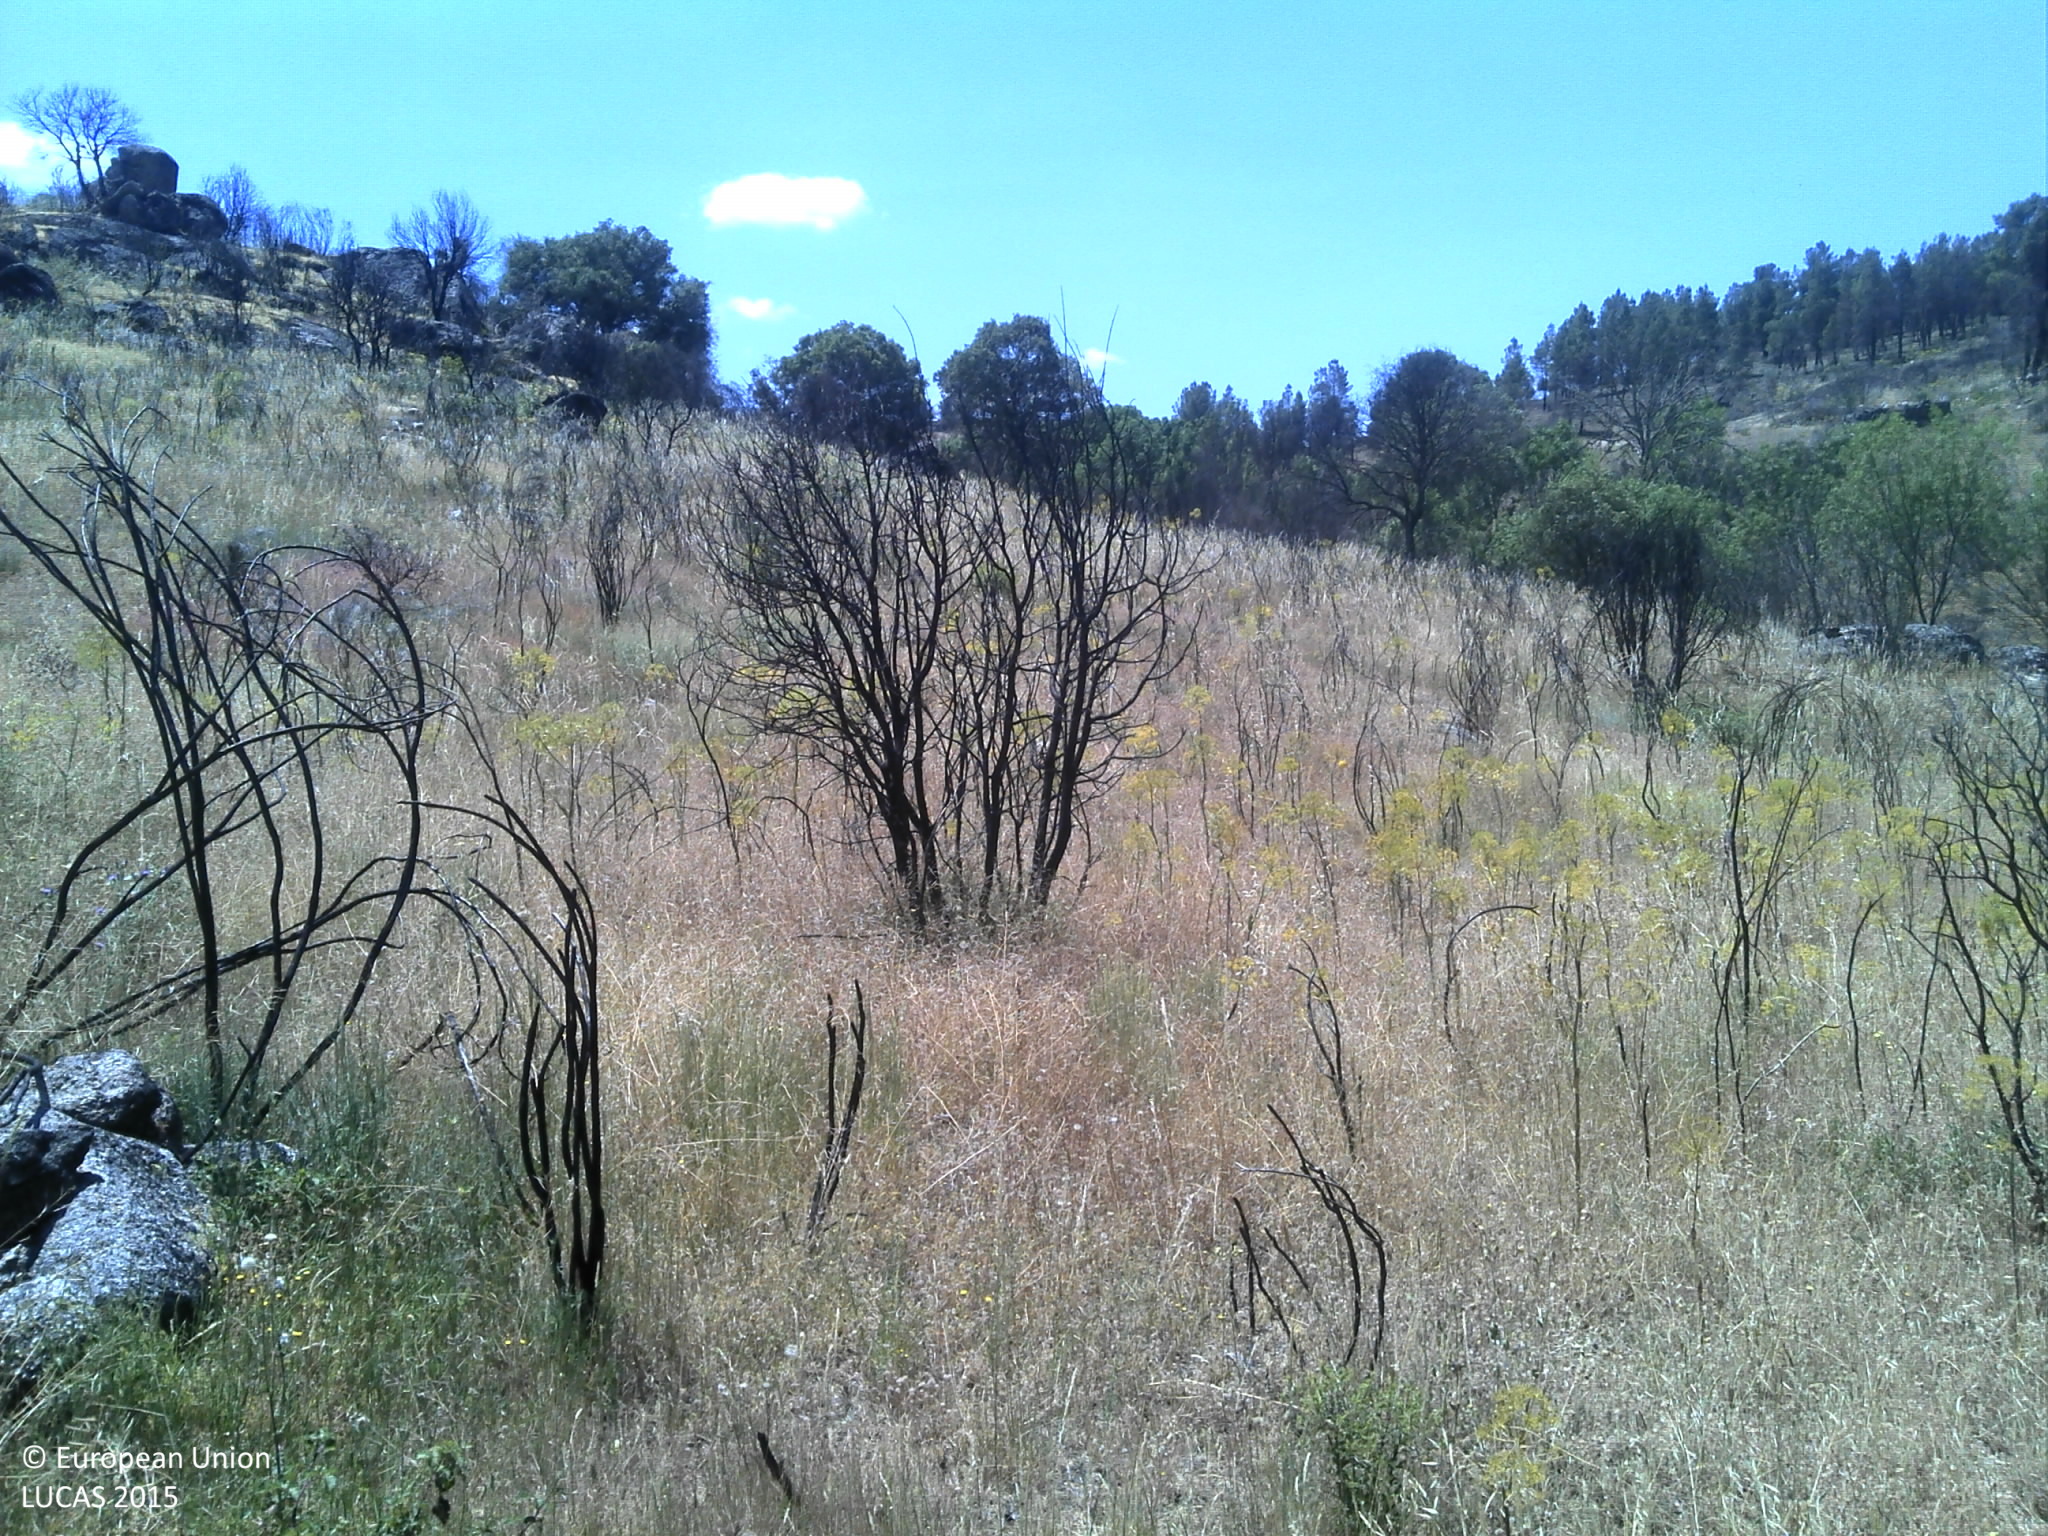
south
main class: Grassland
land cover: Grassland with sparse tree/shrub cover
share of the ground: 50 - 75 %
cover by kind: herbaceous plants 60 %, unconsolidated bare surface 30 %, broadleaved forest trees 5 %, shrubs 5 %
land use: Semi-natural and natural areas not in use
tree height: < 5 m
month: June
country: PT
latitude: 40.6813
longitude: -6.9368
